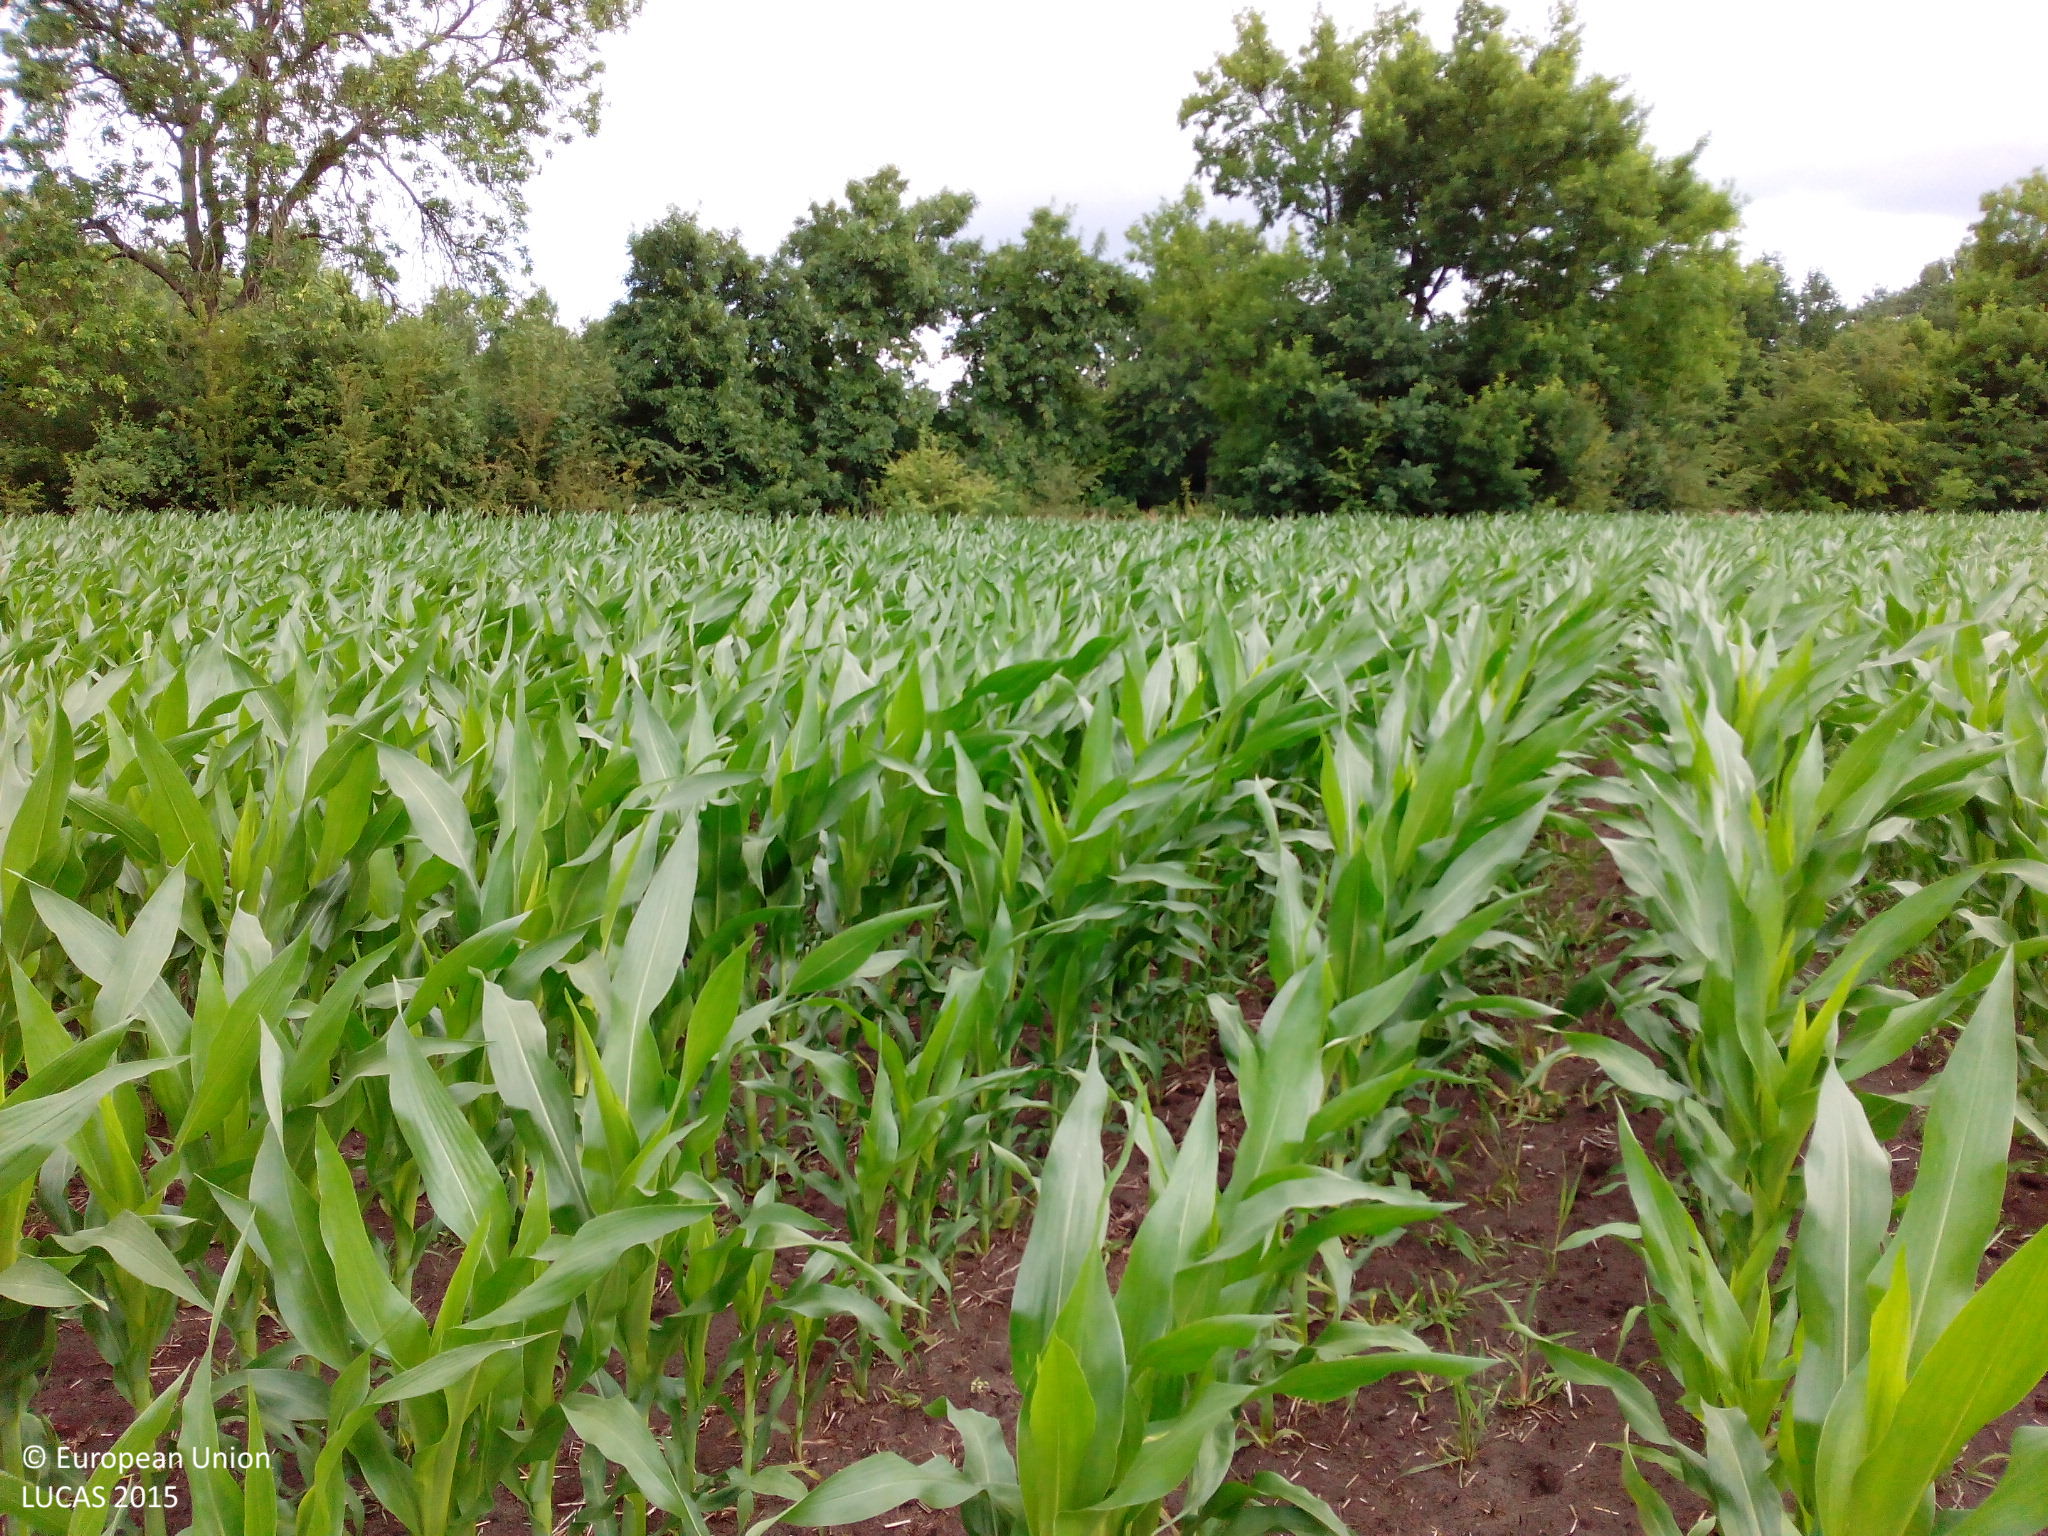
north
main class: Cropland
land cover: Maize
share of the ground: 50 - 75 %
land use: Agriculture (excluding fallow land and kitchen gardens)
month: July
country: DE
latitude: 52.8462
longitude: 13.5488
